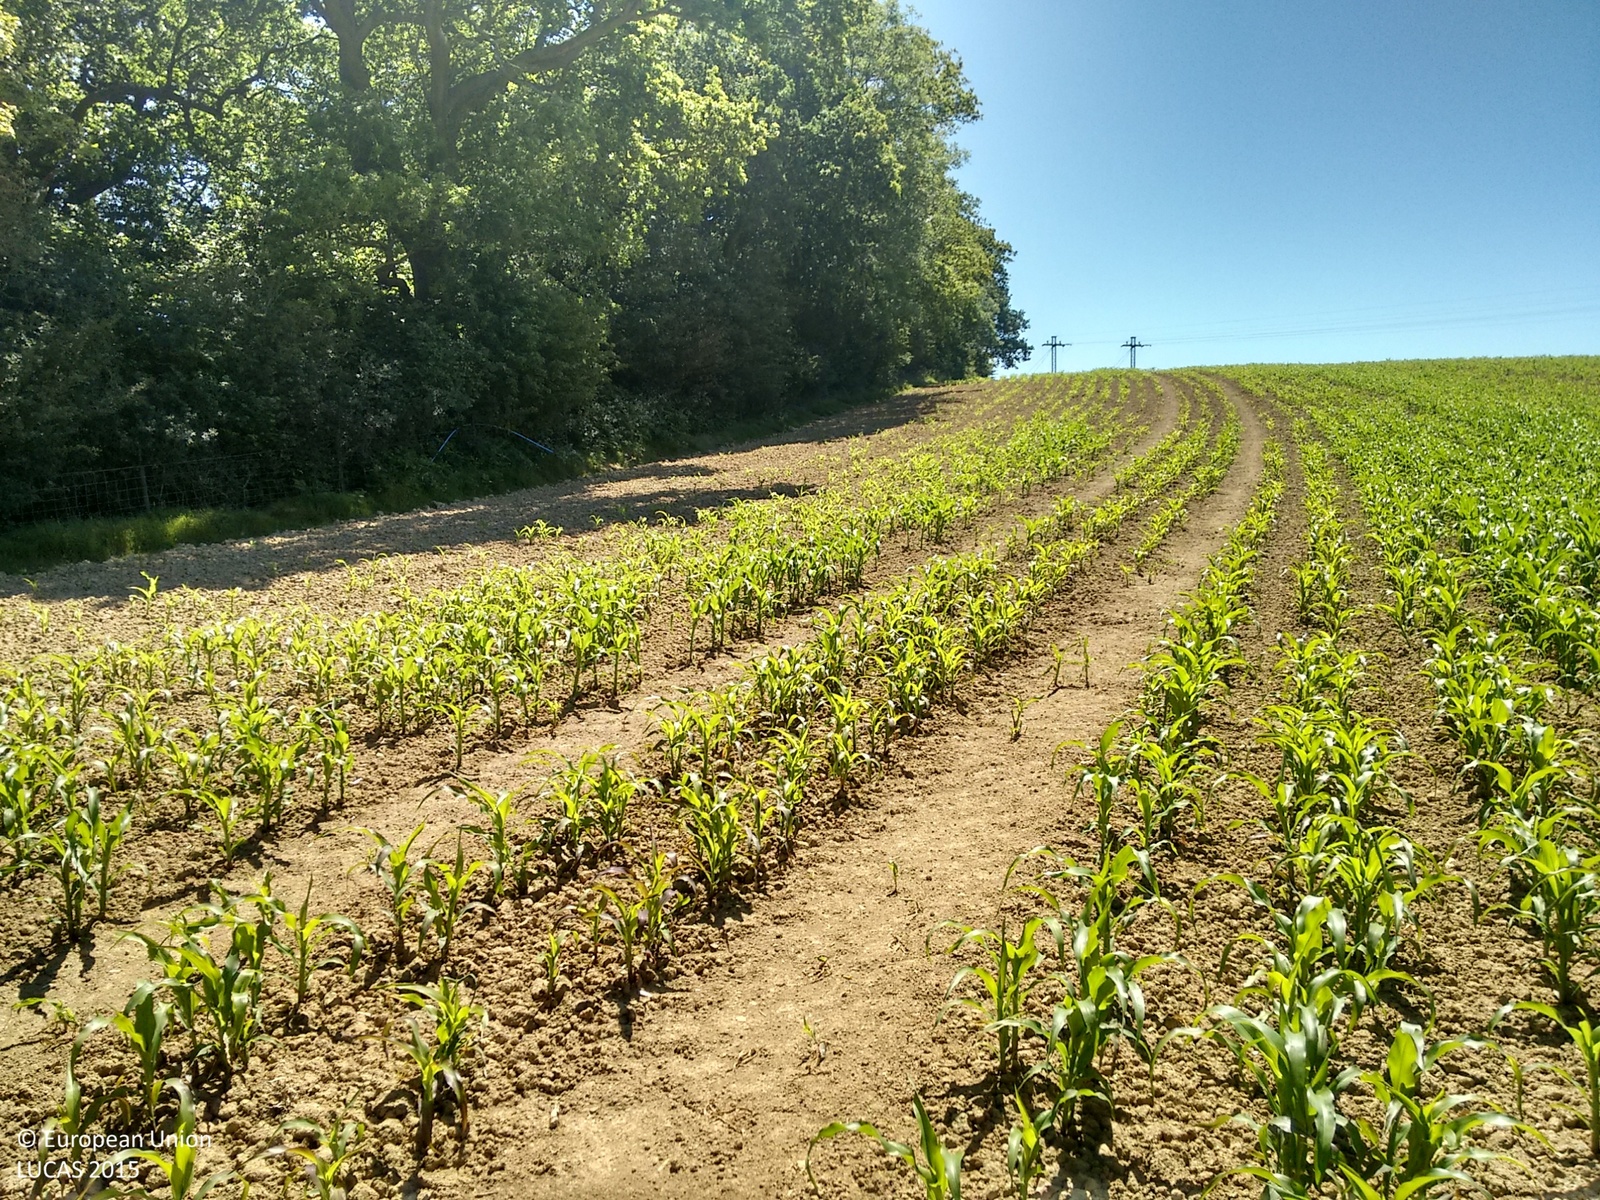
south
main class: Cropland
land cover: Maize
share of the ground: > 75 %
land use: Agriculture (excluding fallow land and kitchen gardens)
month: June
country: GB
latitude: 50.9113
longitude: -0.3191
